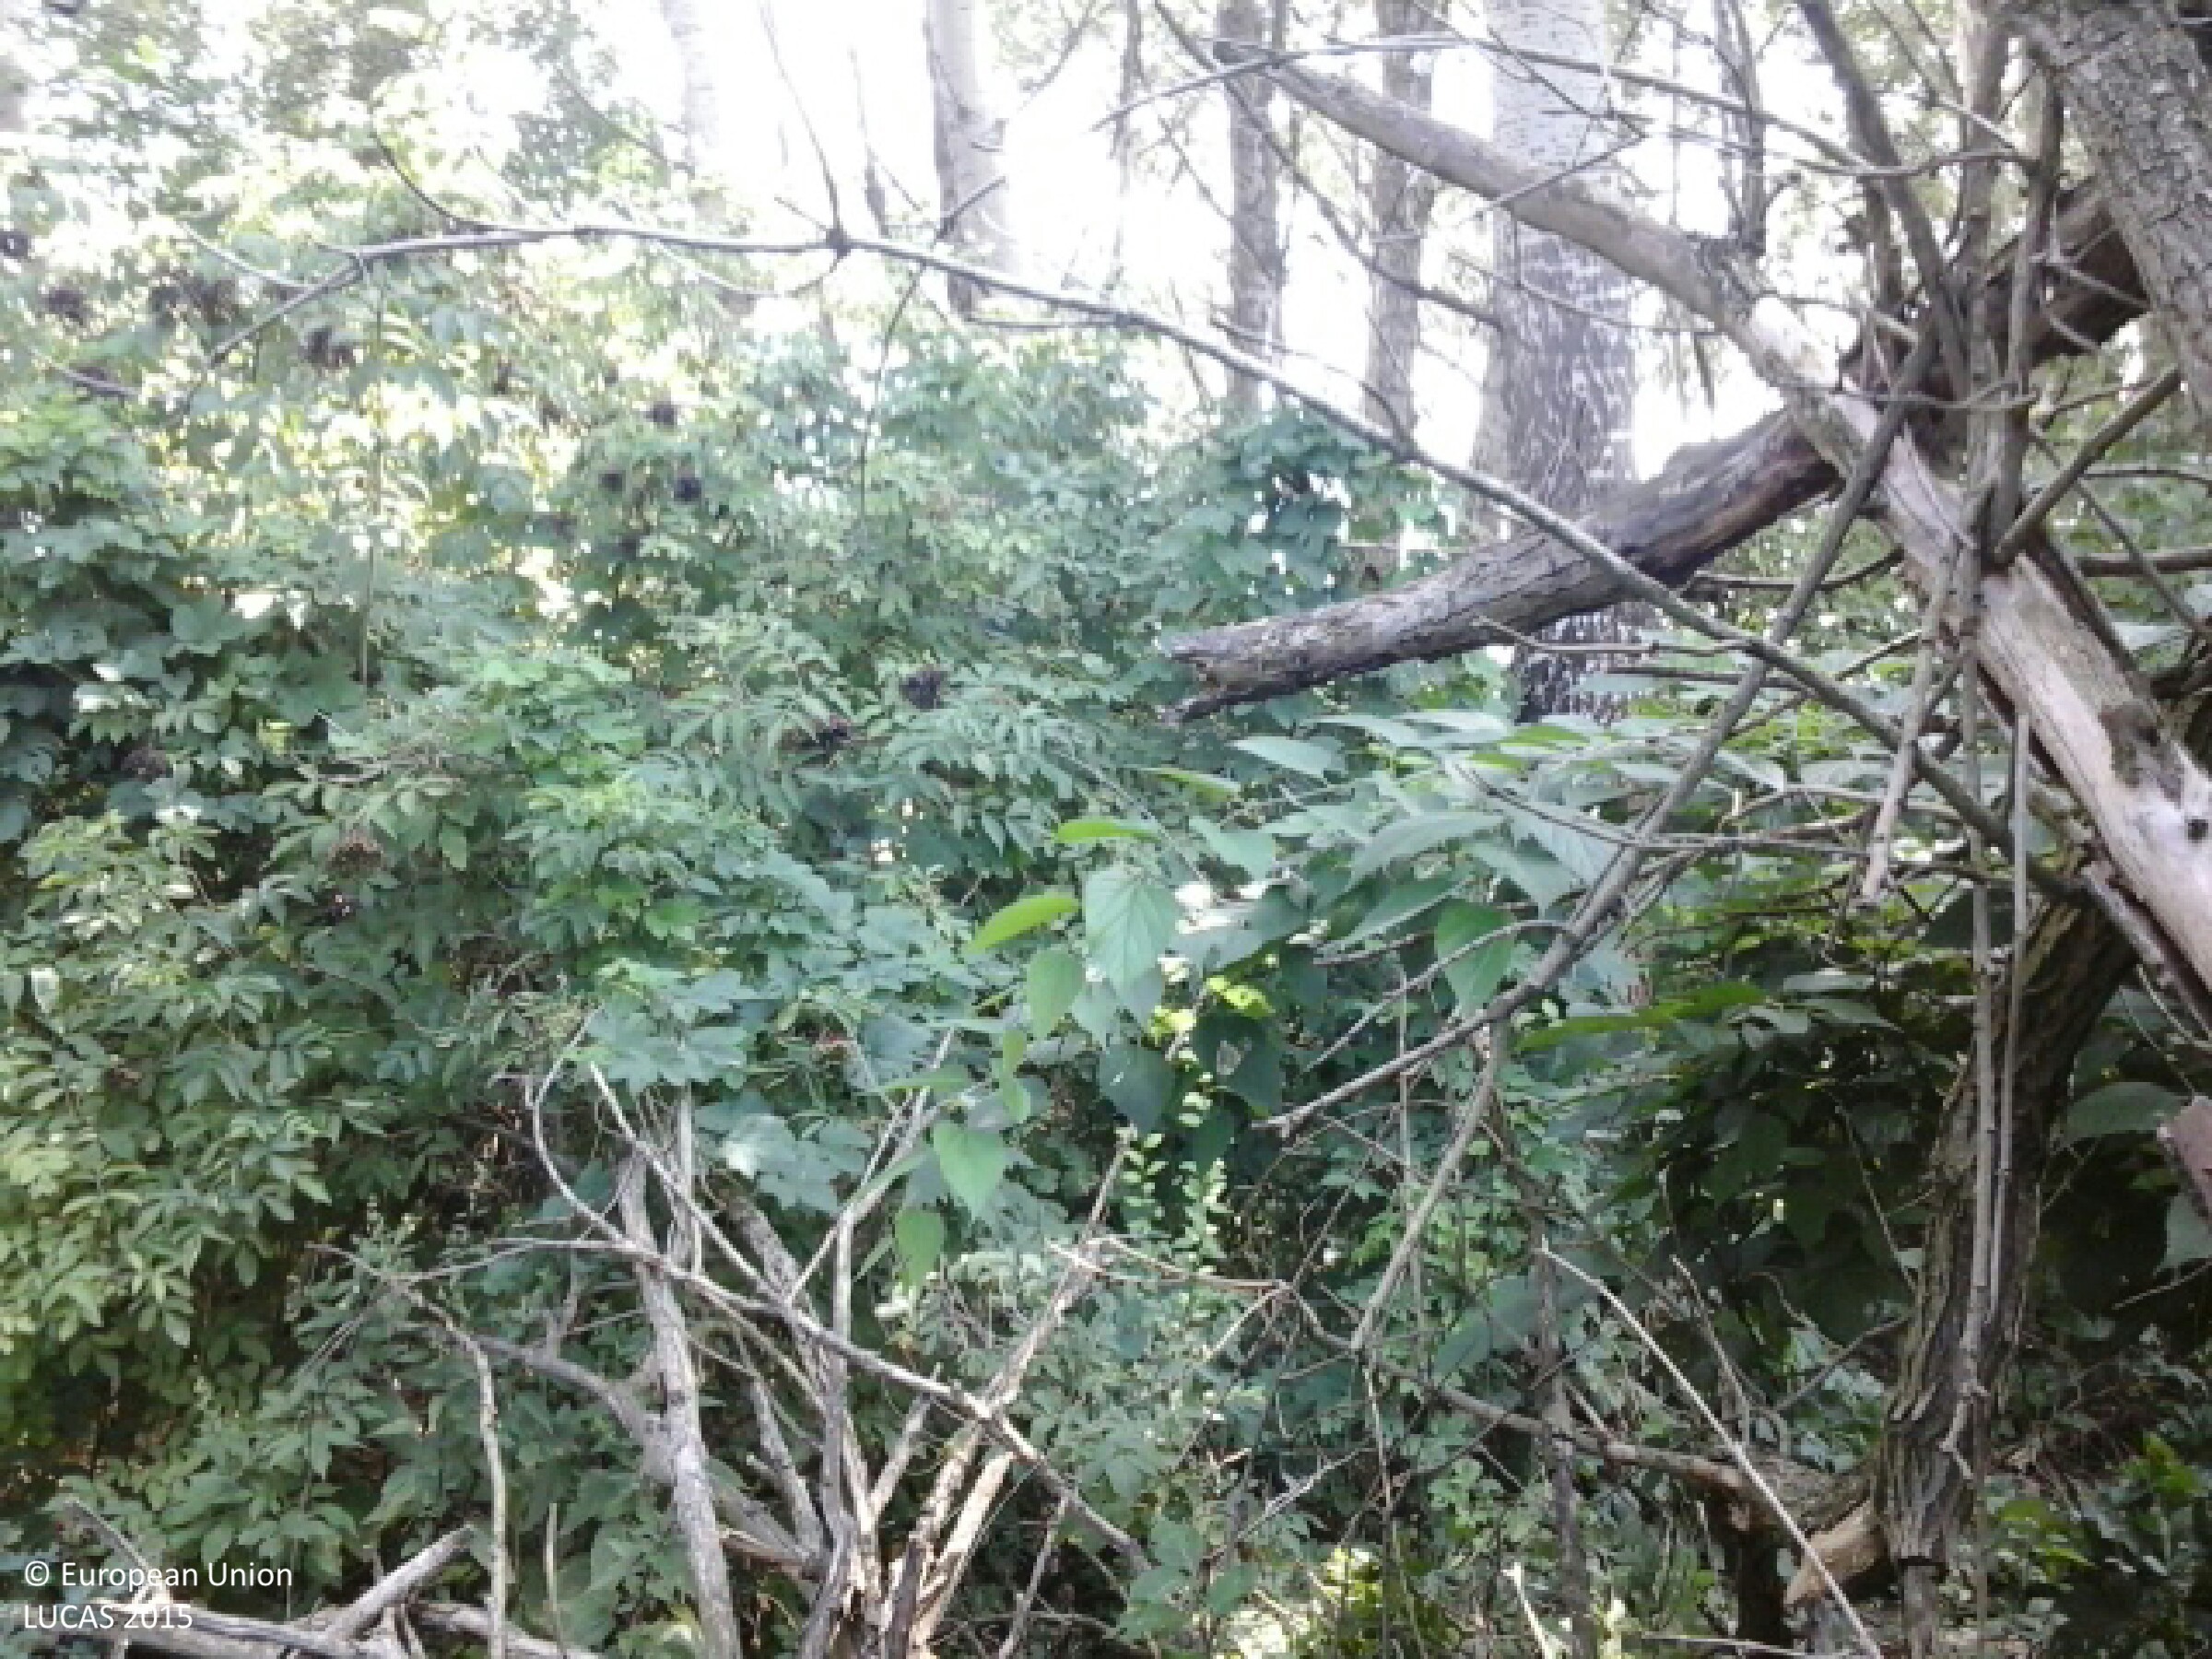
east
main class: Woodland
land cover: Broadleaved woodland
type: mesophytic deciduous forest
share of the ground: > 75 %
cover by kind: broadleaved forest trees 100 %
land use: Semi-natural and natural areas not in use
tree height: > 5 m
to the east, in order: Broadleaved woodland; Ditches and canals; Broadleaved woodland; Common wheat
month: August
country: HU
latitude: 47.7060
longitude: 18.1285
